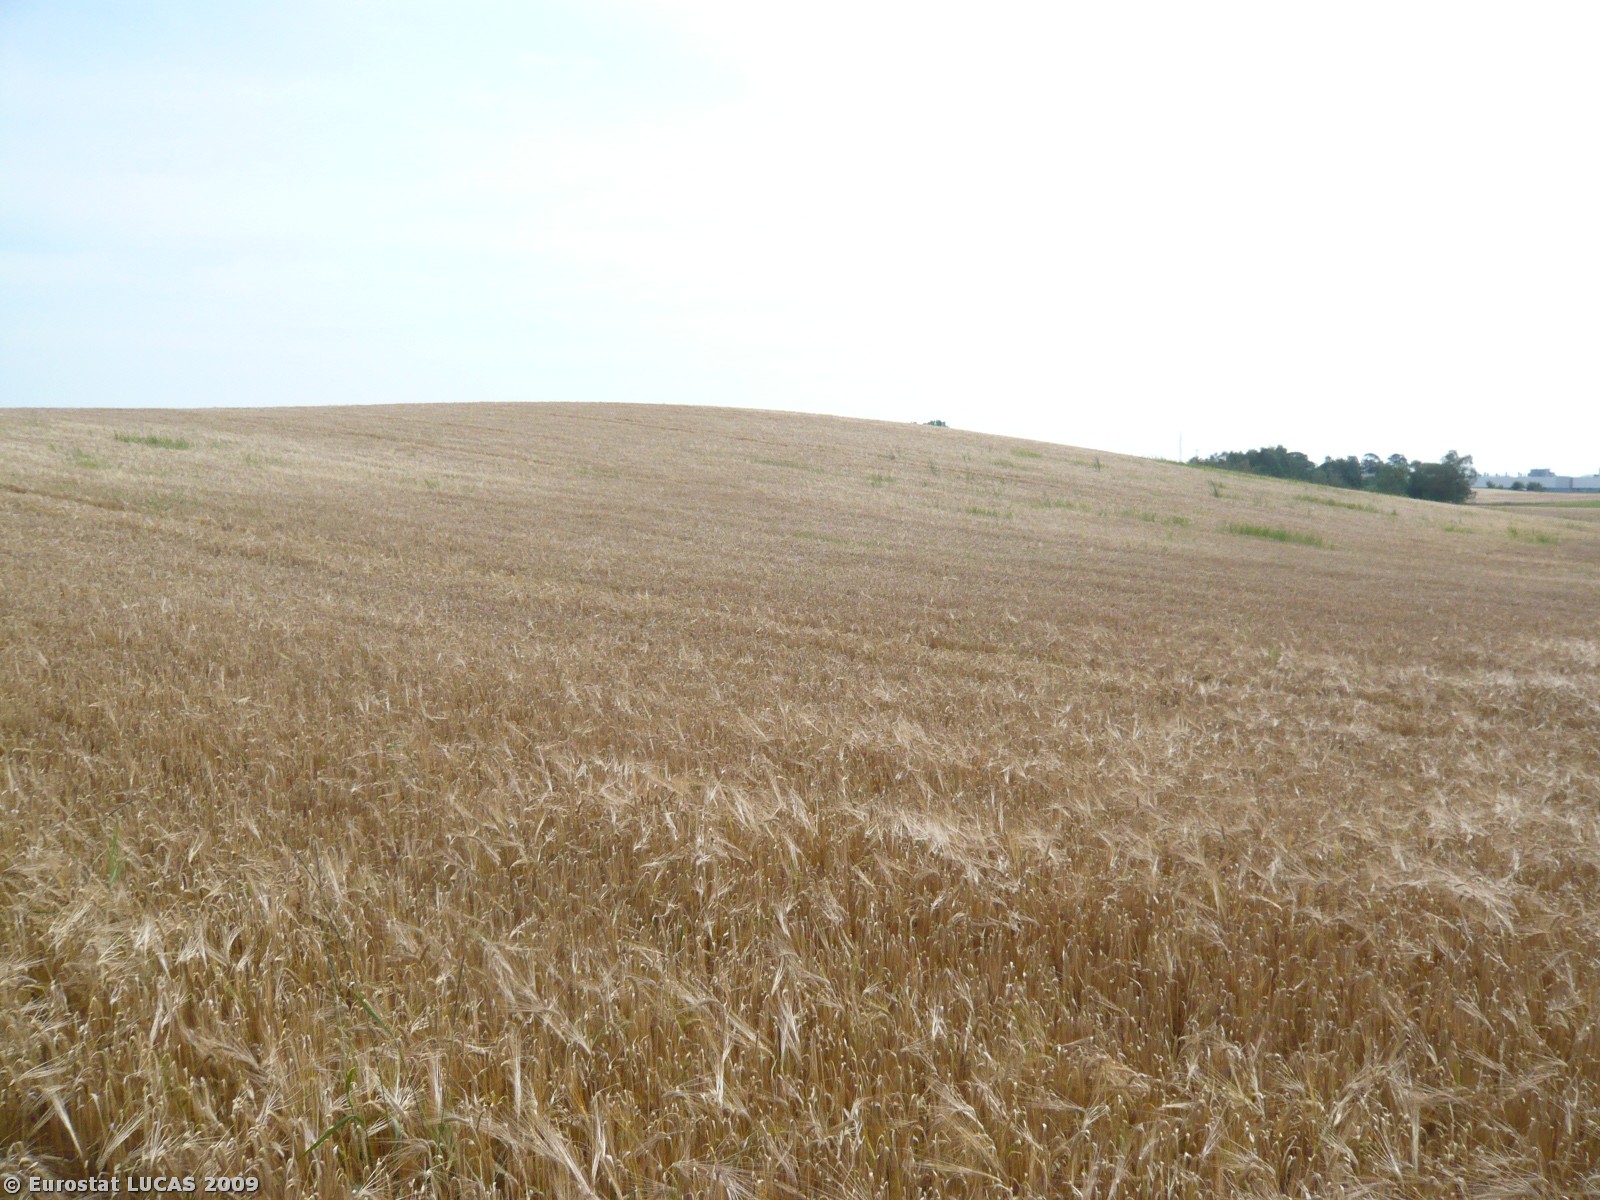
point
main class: Cropland
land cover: Barley
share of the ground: > 75 %
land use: Agriculture (excluding fallow land and kitchen gardens)
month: August
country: DK
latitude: 56.0257
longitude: 12.1640
